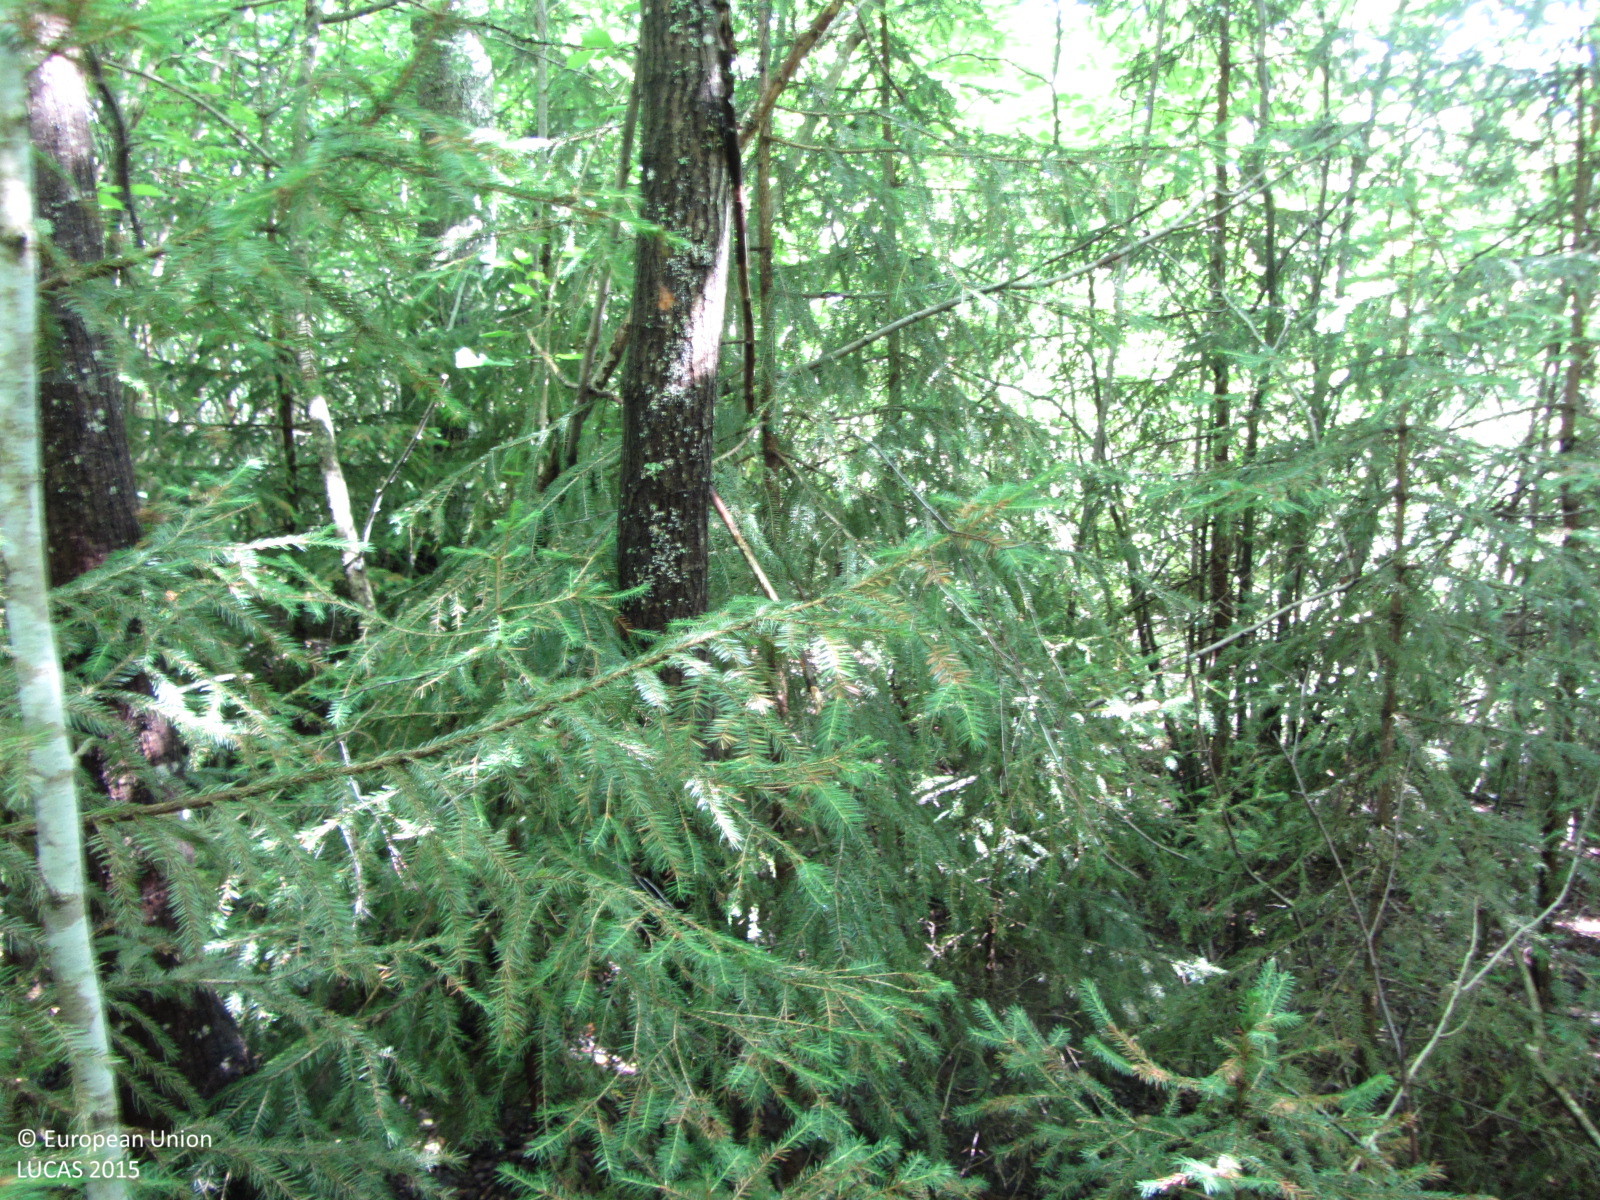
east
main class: Woodland
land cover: Spruce dominated mixed woodland
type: hemiboreal forest and nemoral coniferous forest and mixed broadleaved-coniferous forest
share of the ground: > 75 %
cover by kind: broadleaved forest trees 55 %, coniferous forest trees 35 %, herbaceous plants 10 %
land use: Forestry
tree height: > 5 m
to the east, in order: Spruce dominated mixed woodland; Broadleaved woodland; Ditches and canals; Tracks; Grassland with sparse tree/shrub cover; Conifer hedges; Other mixed woodland
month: July
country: FI
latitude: 60.1841
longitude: 24.4415
